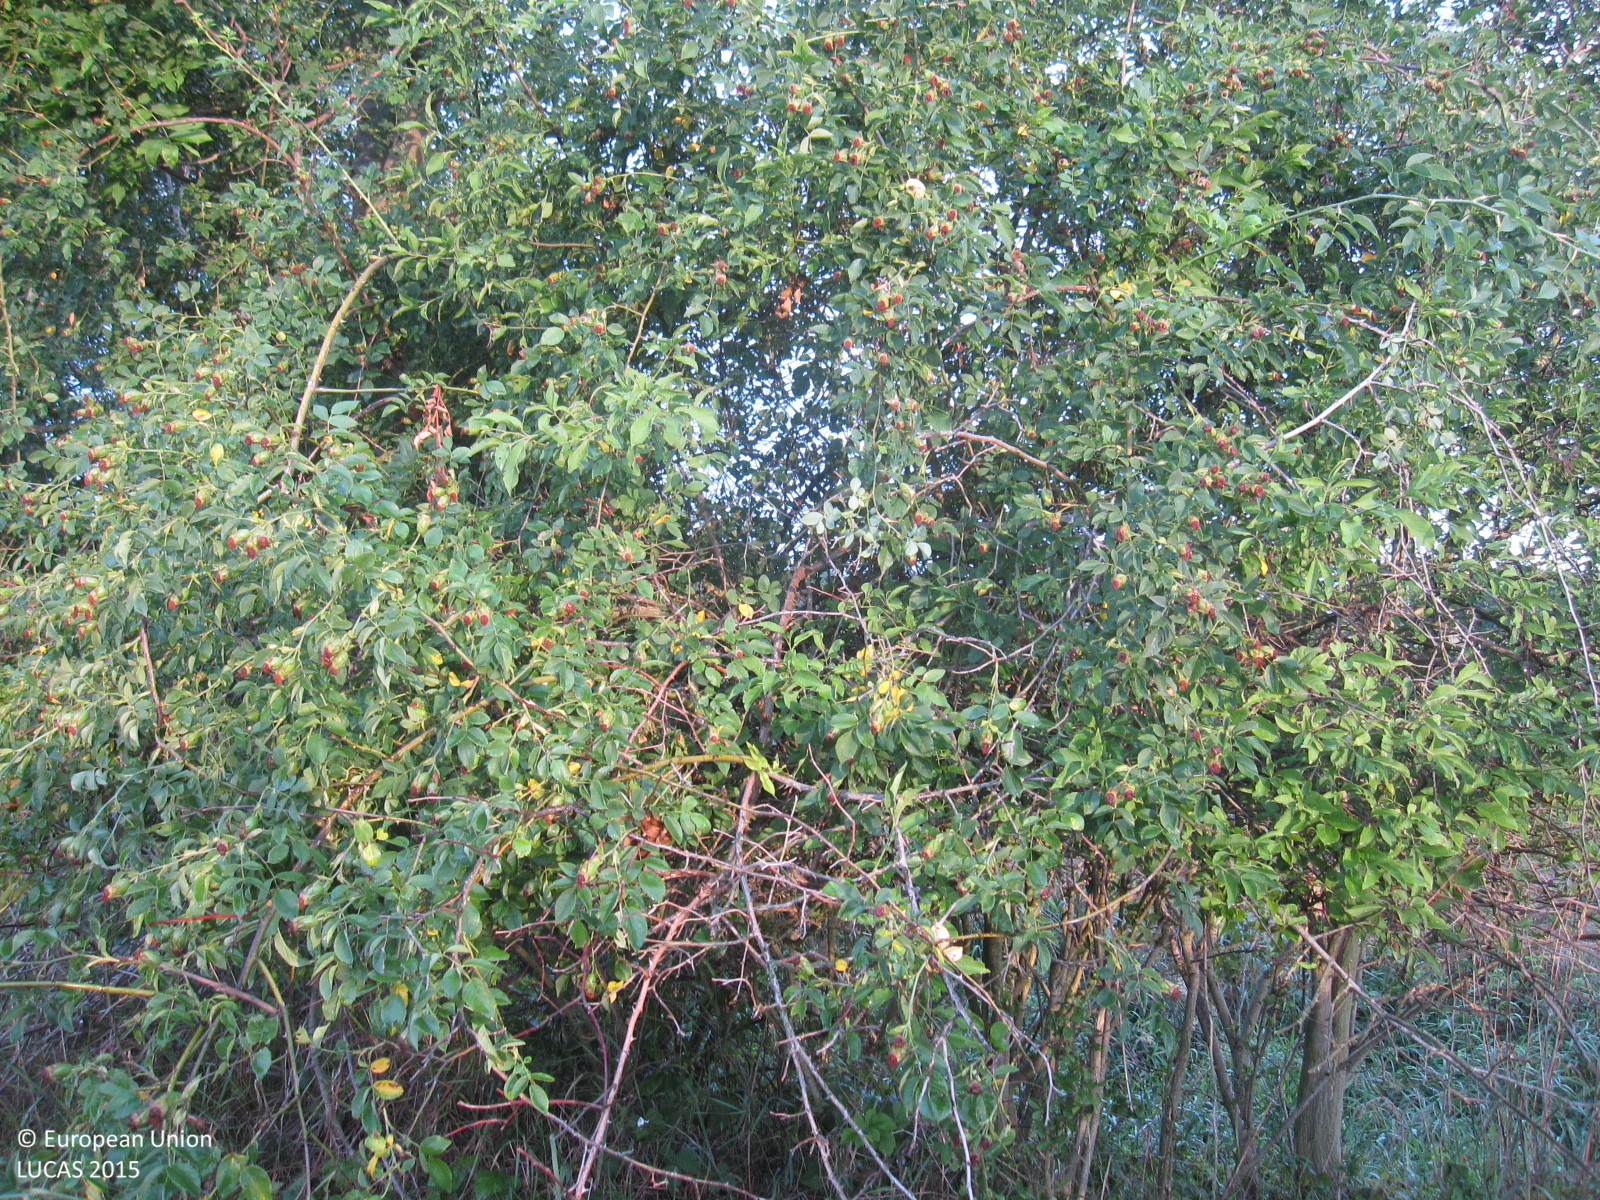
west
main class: Cropland
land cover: Maize
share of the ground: > 75 %
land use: Agriculture (excluding fallow land and kitchen gardens)
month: July
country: DE
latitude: 51.0807
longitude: 12.1837
